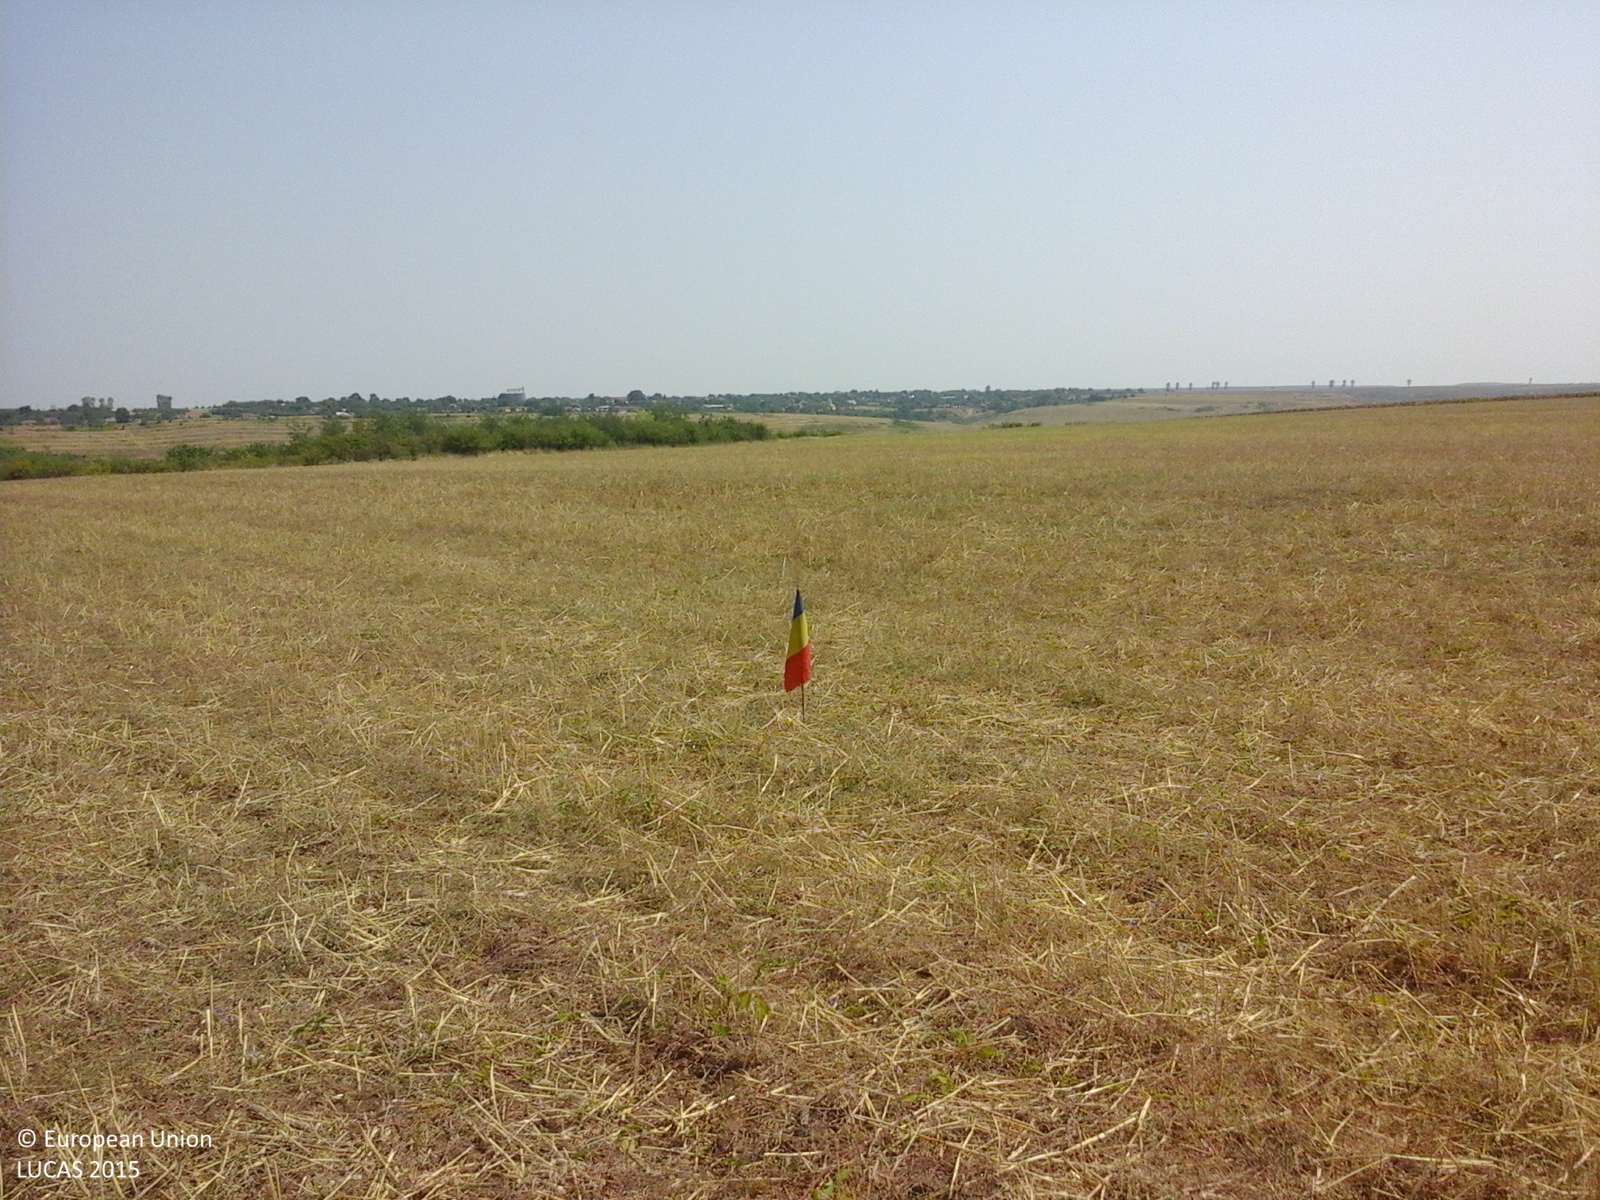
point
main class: Cropland
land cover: Common wheat
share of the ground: 50 - 75 %
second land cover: Spontaneously vegetated surfaces
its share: 50 - 75 %
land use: Agriculture (excluding fallow land and kitchen gardens)
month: August
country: RO
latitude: 44.2264
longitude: 23.2542
